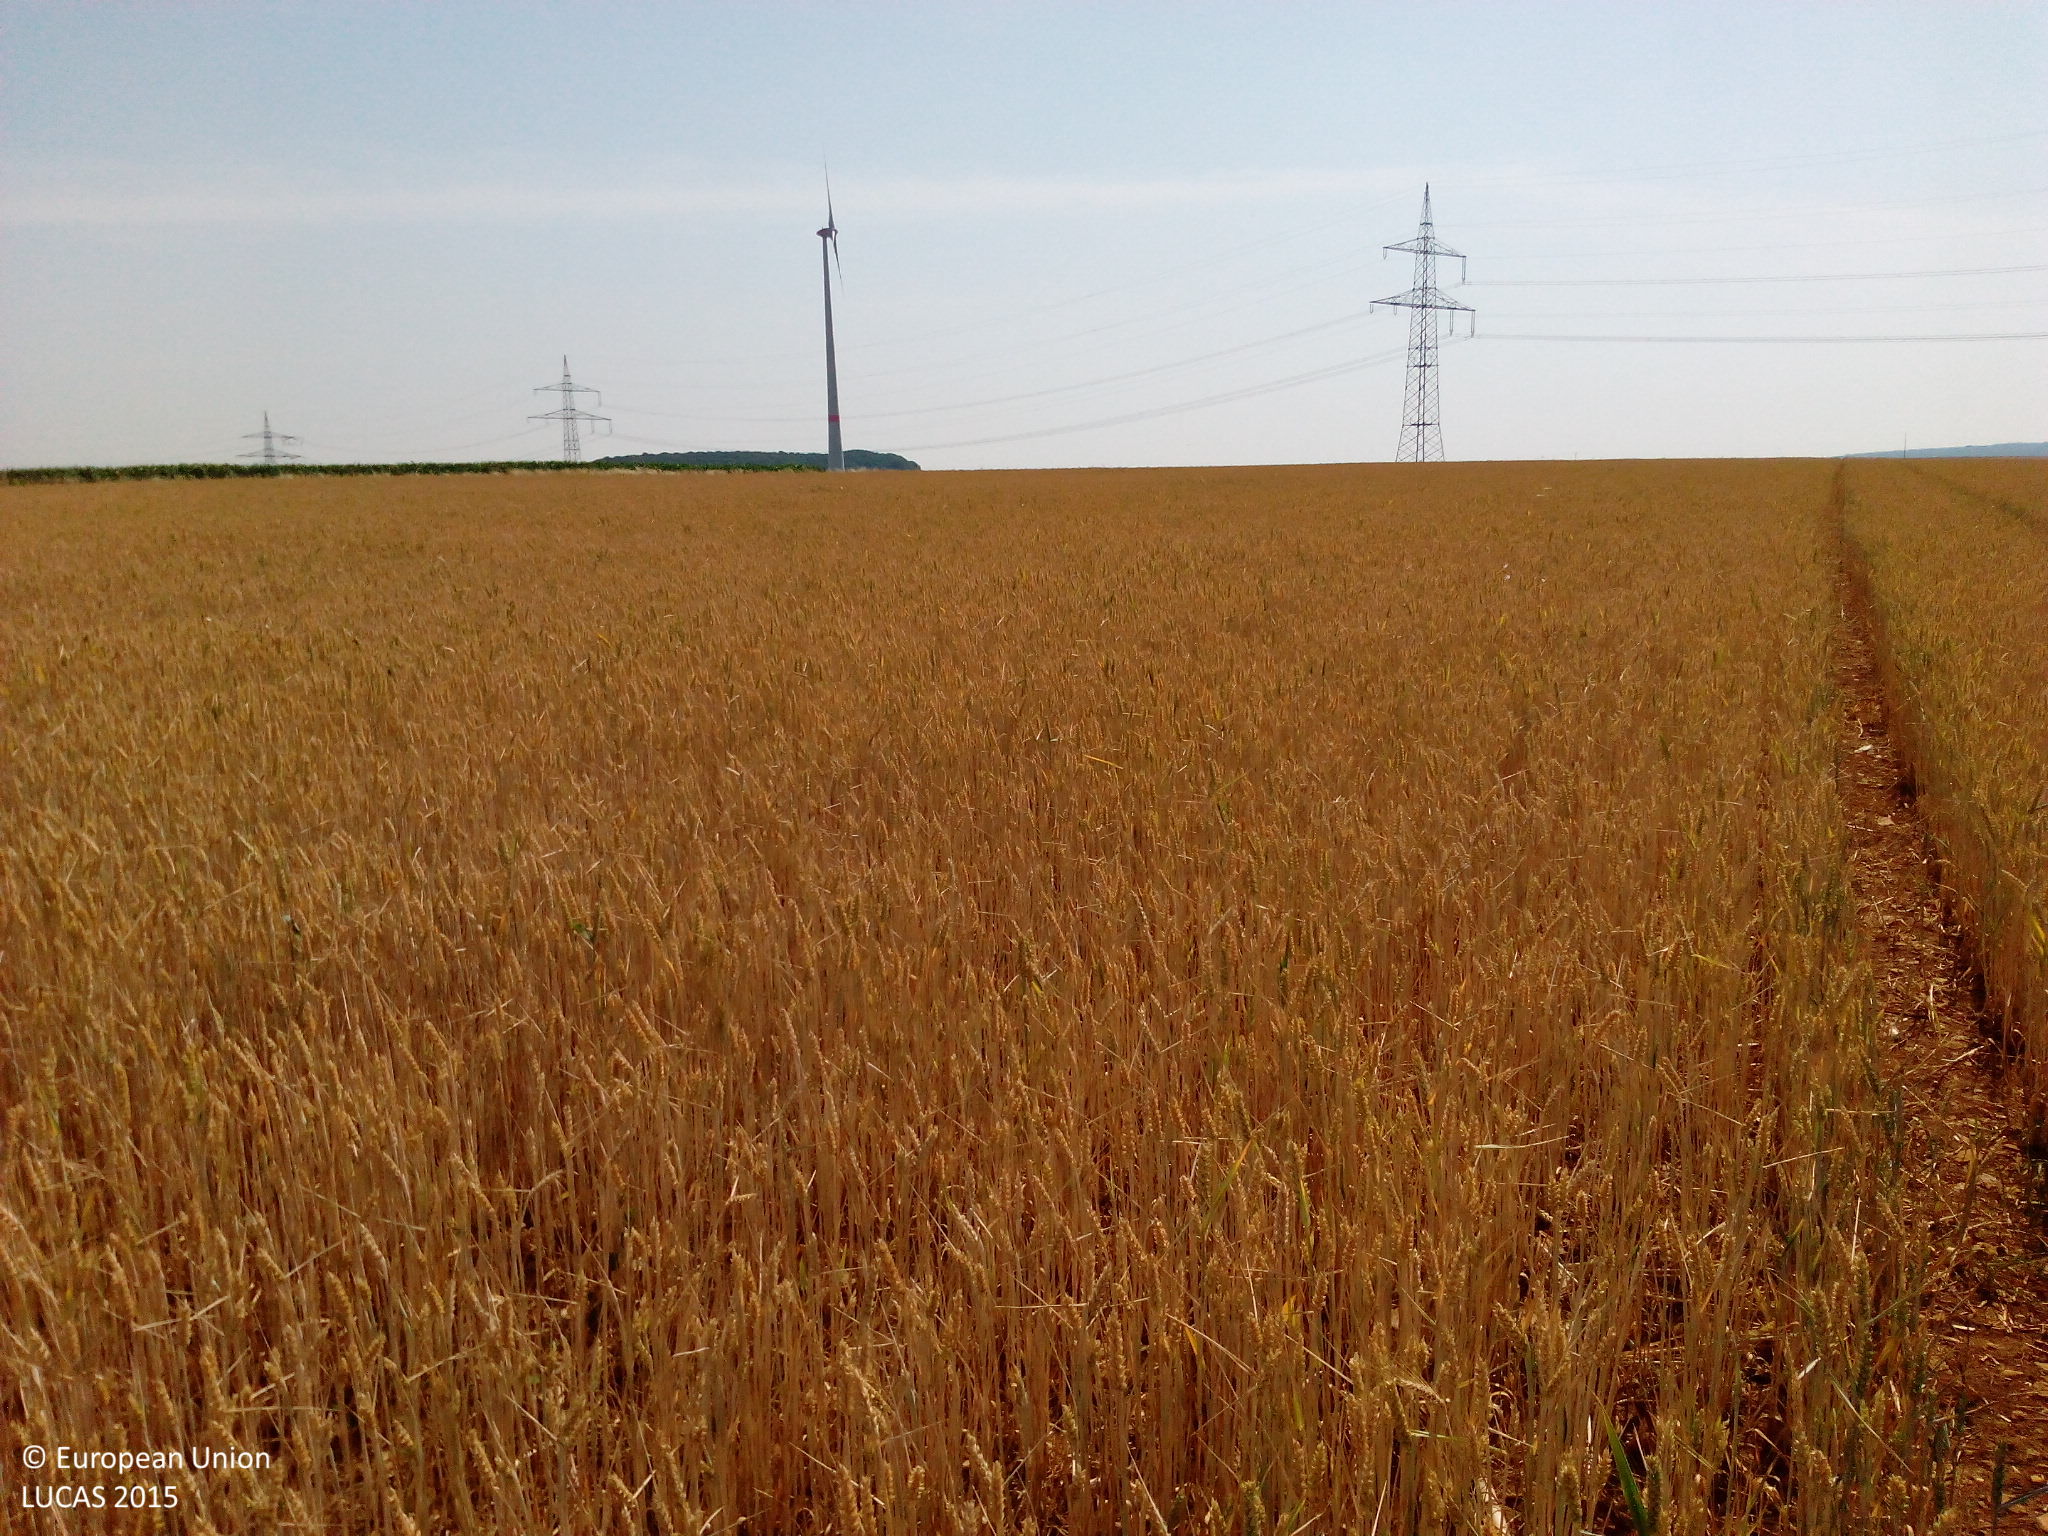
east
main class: Cropland
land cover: Common wheat
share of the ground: > 75 %
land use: Agriculture (excluding fallow land and kitchen gardens)
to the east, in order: Common wheat; Ditches and canals; Grass margins; Tracks; Common wheat
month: July
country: DE
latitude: 49.5188
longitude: 9.9033
